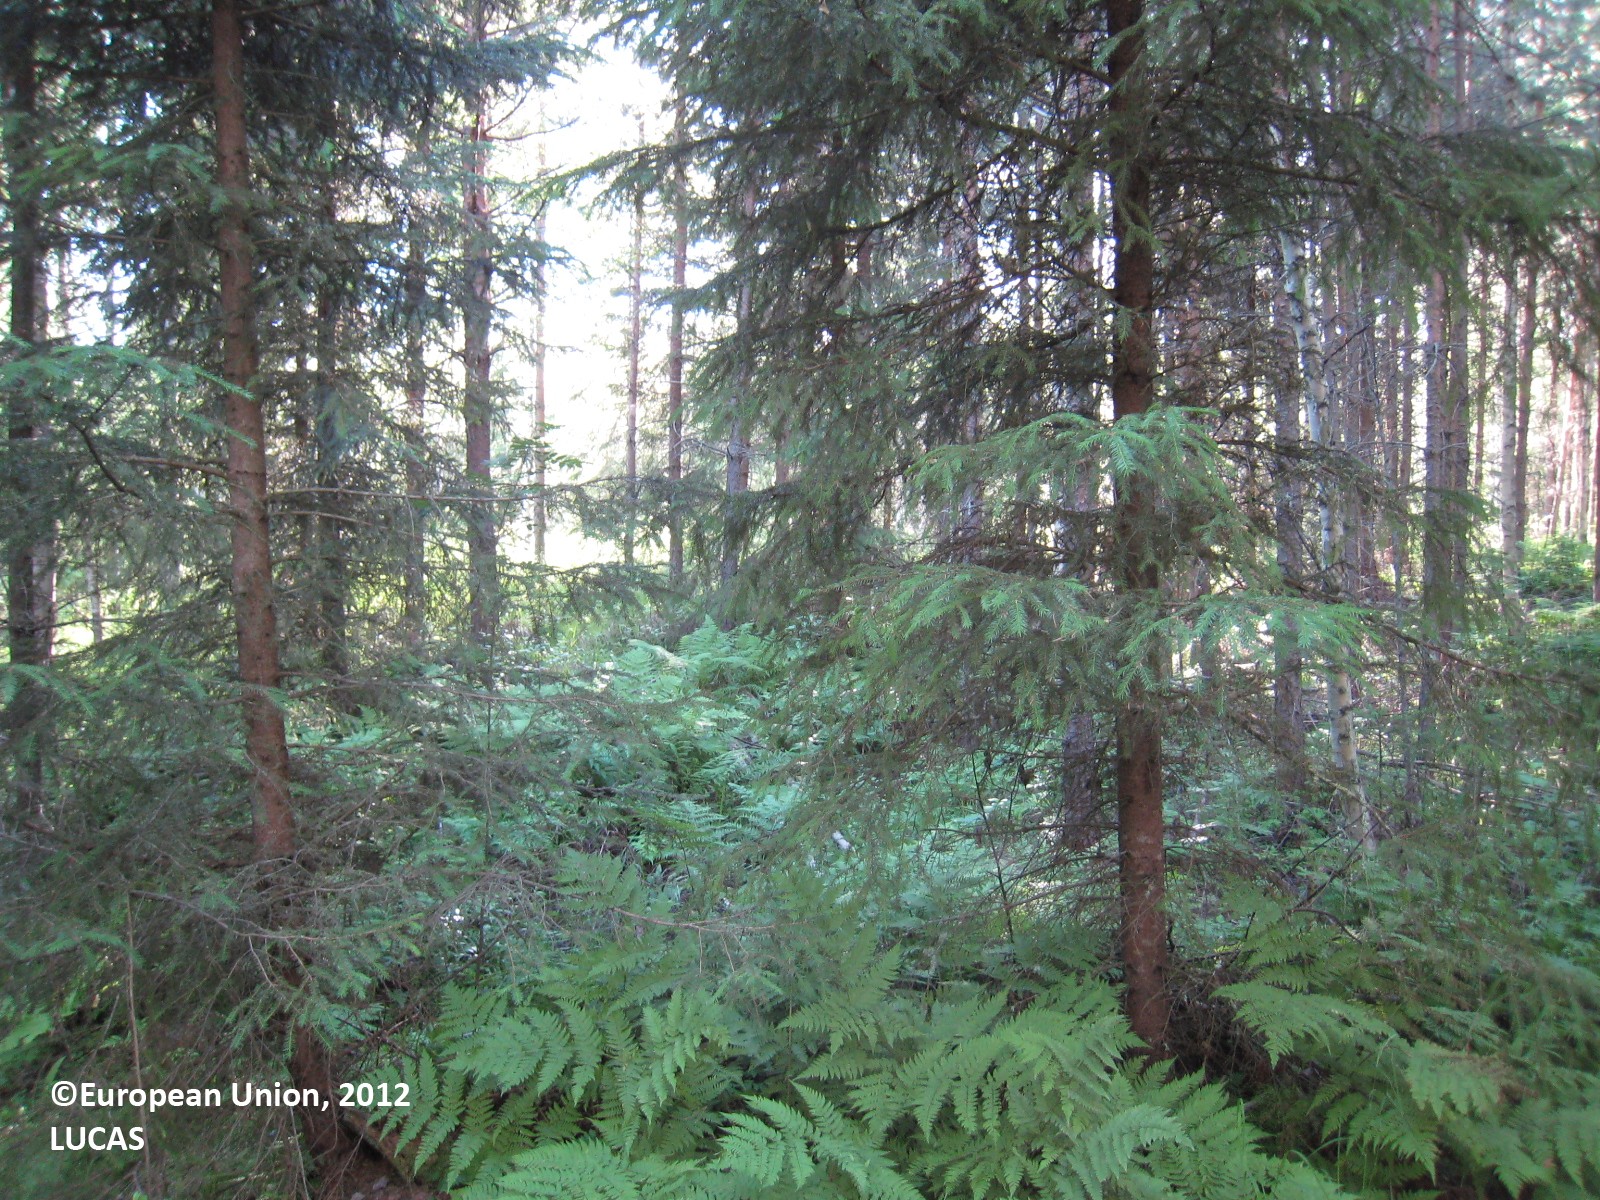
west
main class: Woodland
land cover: Other mixed woodland
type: boreal forest
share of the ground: > 75 %
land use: Forestry
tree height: > 5 m
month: July
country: FI
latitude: 63.1190
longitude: 25.7936
